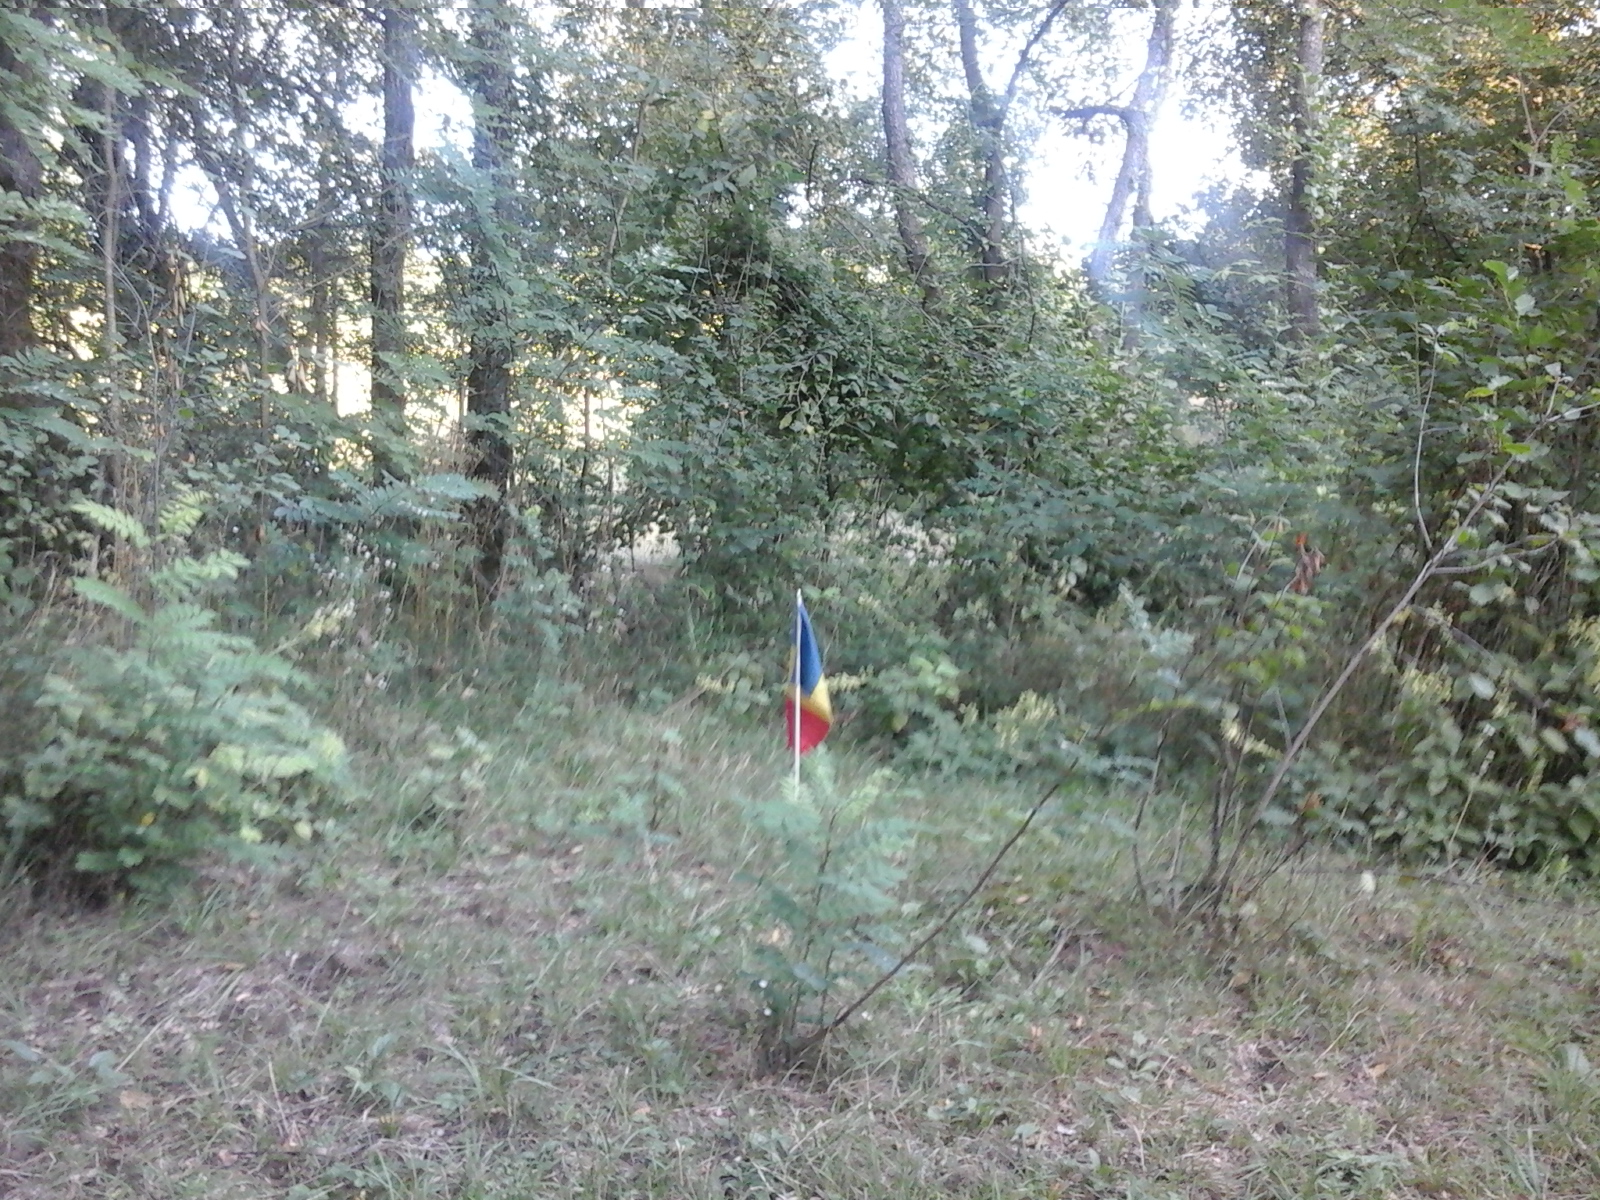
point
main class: Woodland
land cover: Broadleaved woodland
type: exotic forest
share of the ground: > 75 %
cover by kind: broadleaved forest trees 100 %
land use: Forestry
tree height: > 5 m
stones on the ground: < 10 %
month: September
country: RO
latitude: 47.9419
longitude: 23.4496
